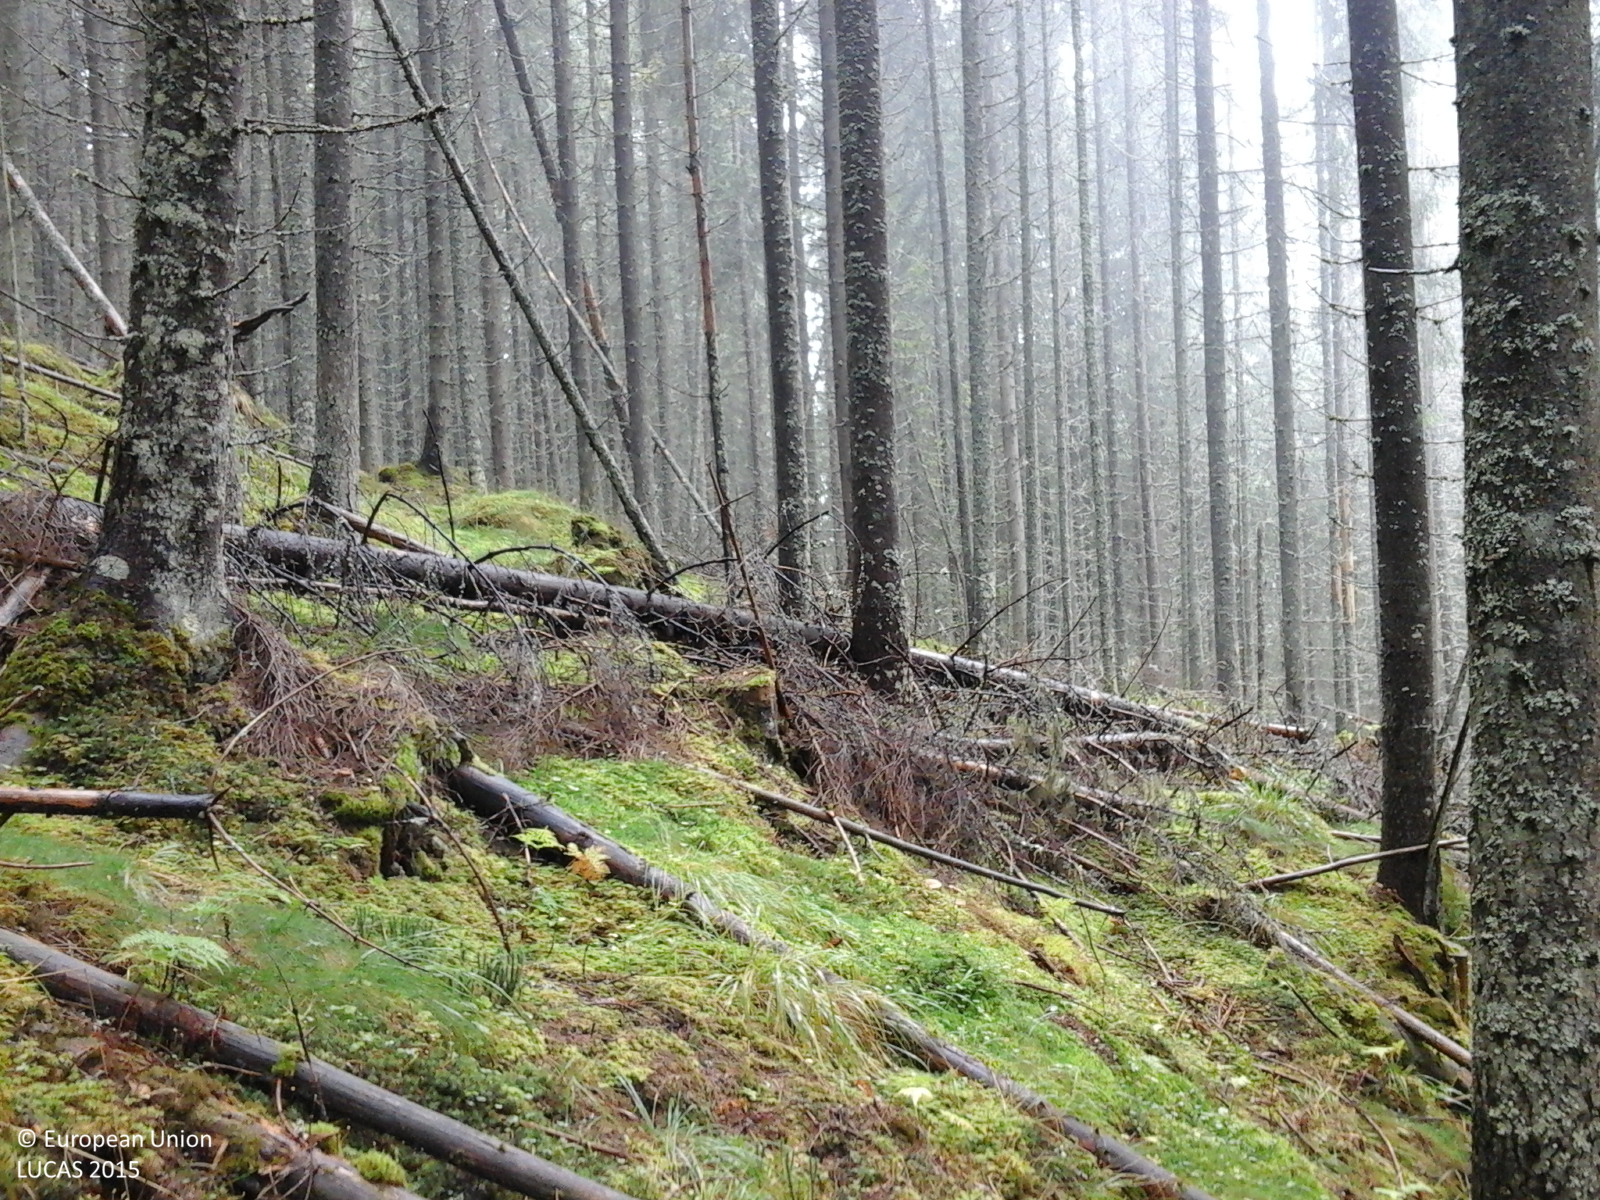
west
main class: Woodland
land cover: Spruce dominated coniferous woodland
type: alpine coniferous forest
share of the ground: > 75 %
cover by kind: coniferous forest trees 100 %
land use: Forestry
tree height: > 5 m
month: September
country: RO
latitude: 45.5969
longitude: 23.6662
